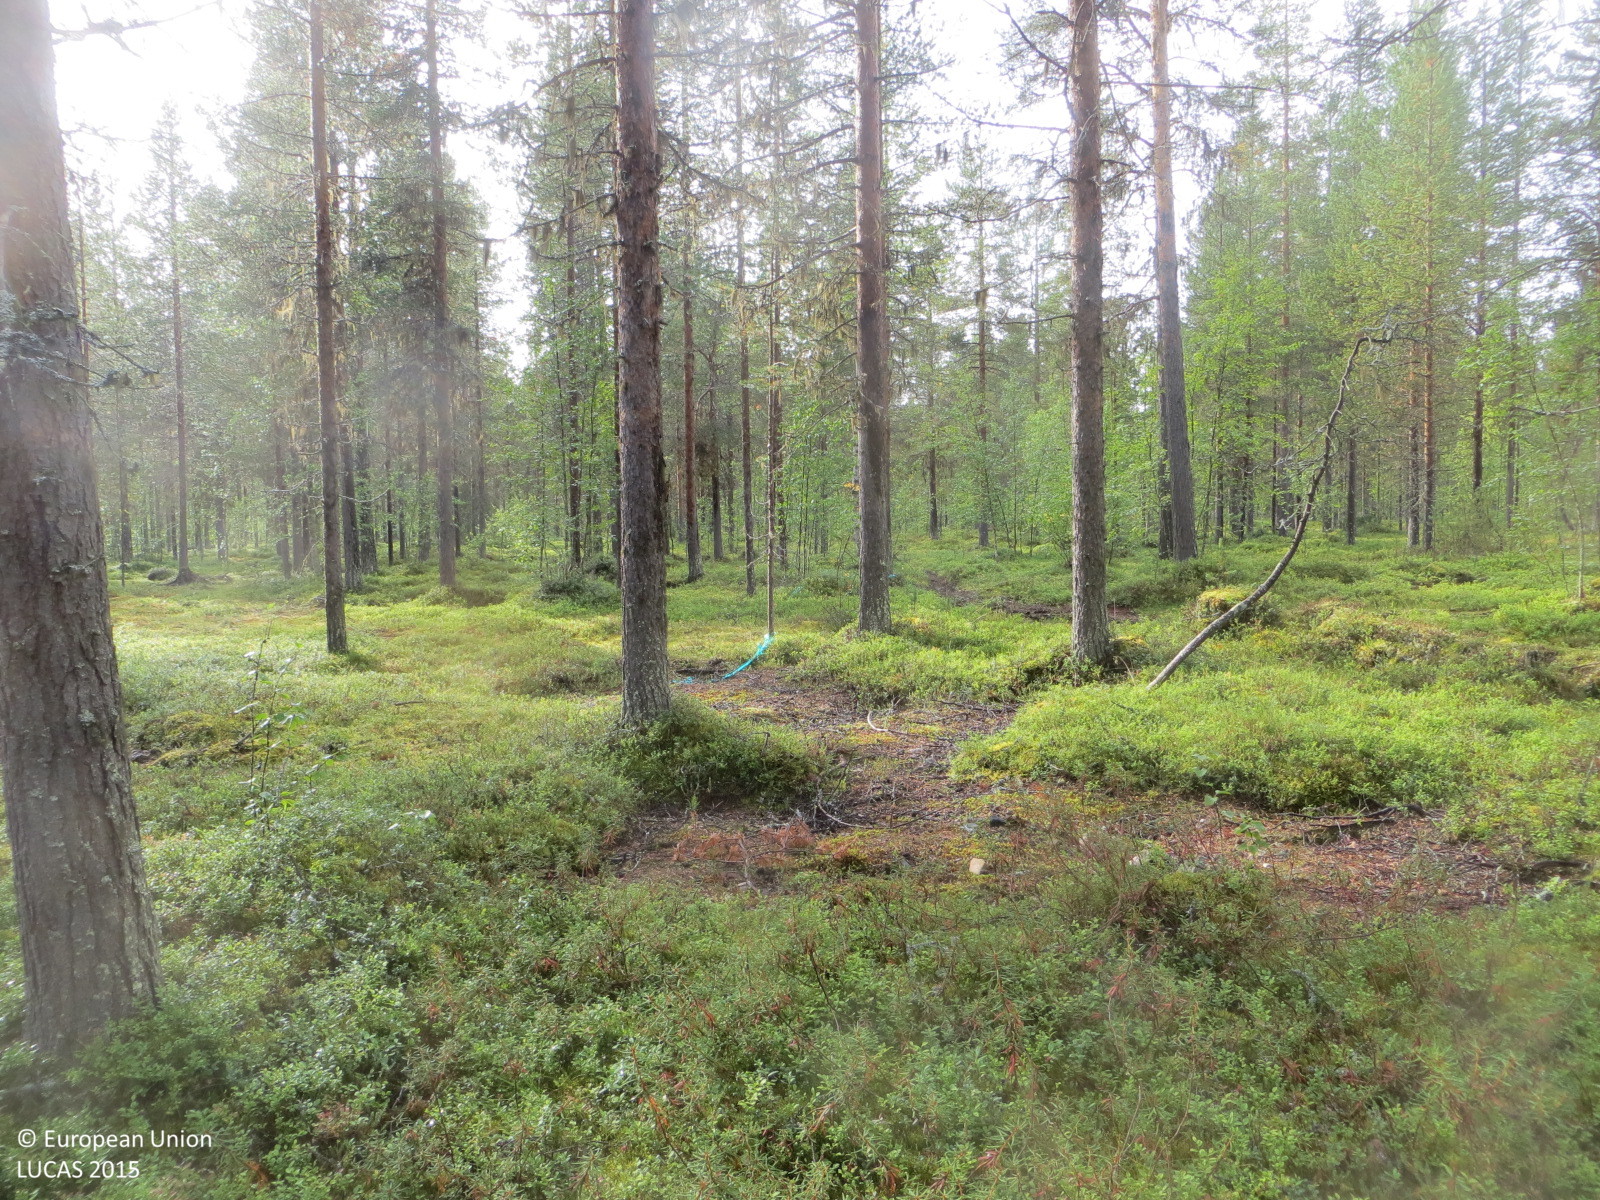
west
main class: Woodland
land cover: Pine dominated coniferous woodland
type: boreal forest
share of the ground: 50 - 75 %
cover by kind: coniferous forest trees 50 %, shrubs 50 %
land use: Forestry
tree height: > 5 m
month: August
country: FI
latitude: 67.8708
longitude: 24.6576
